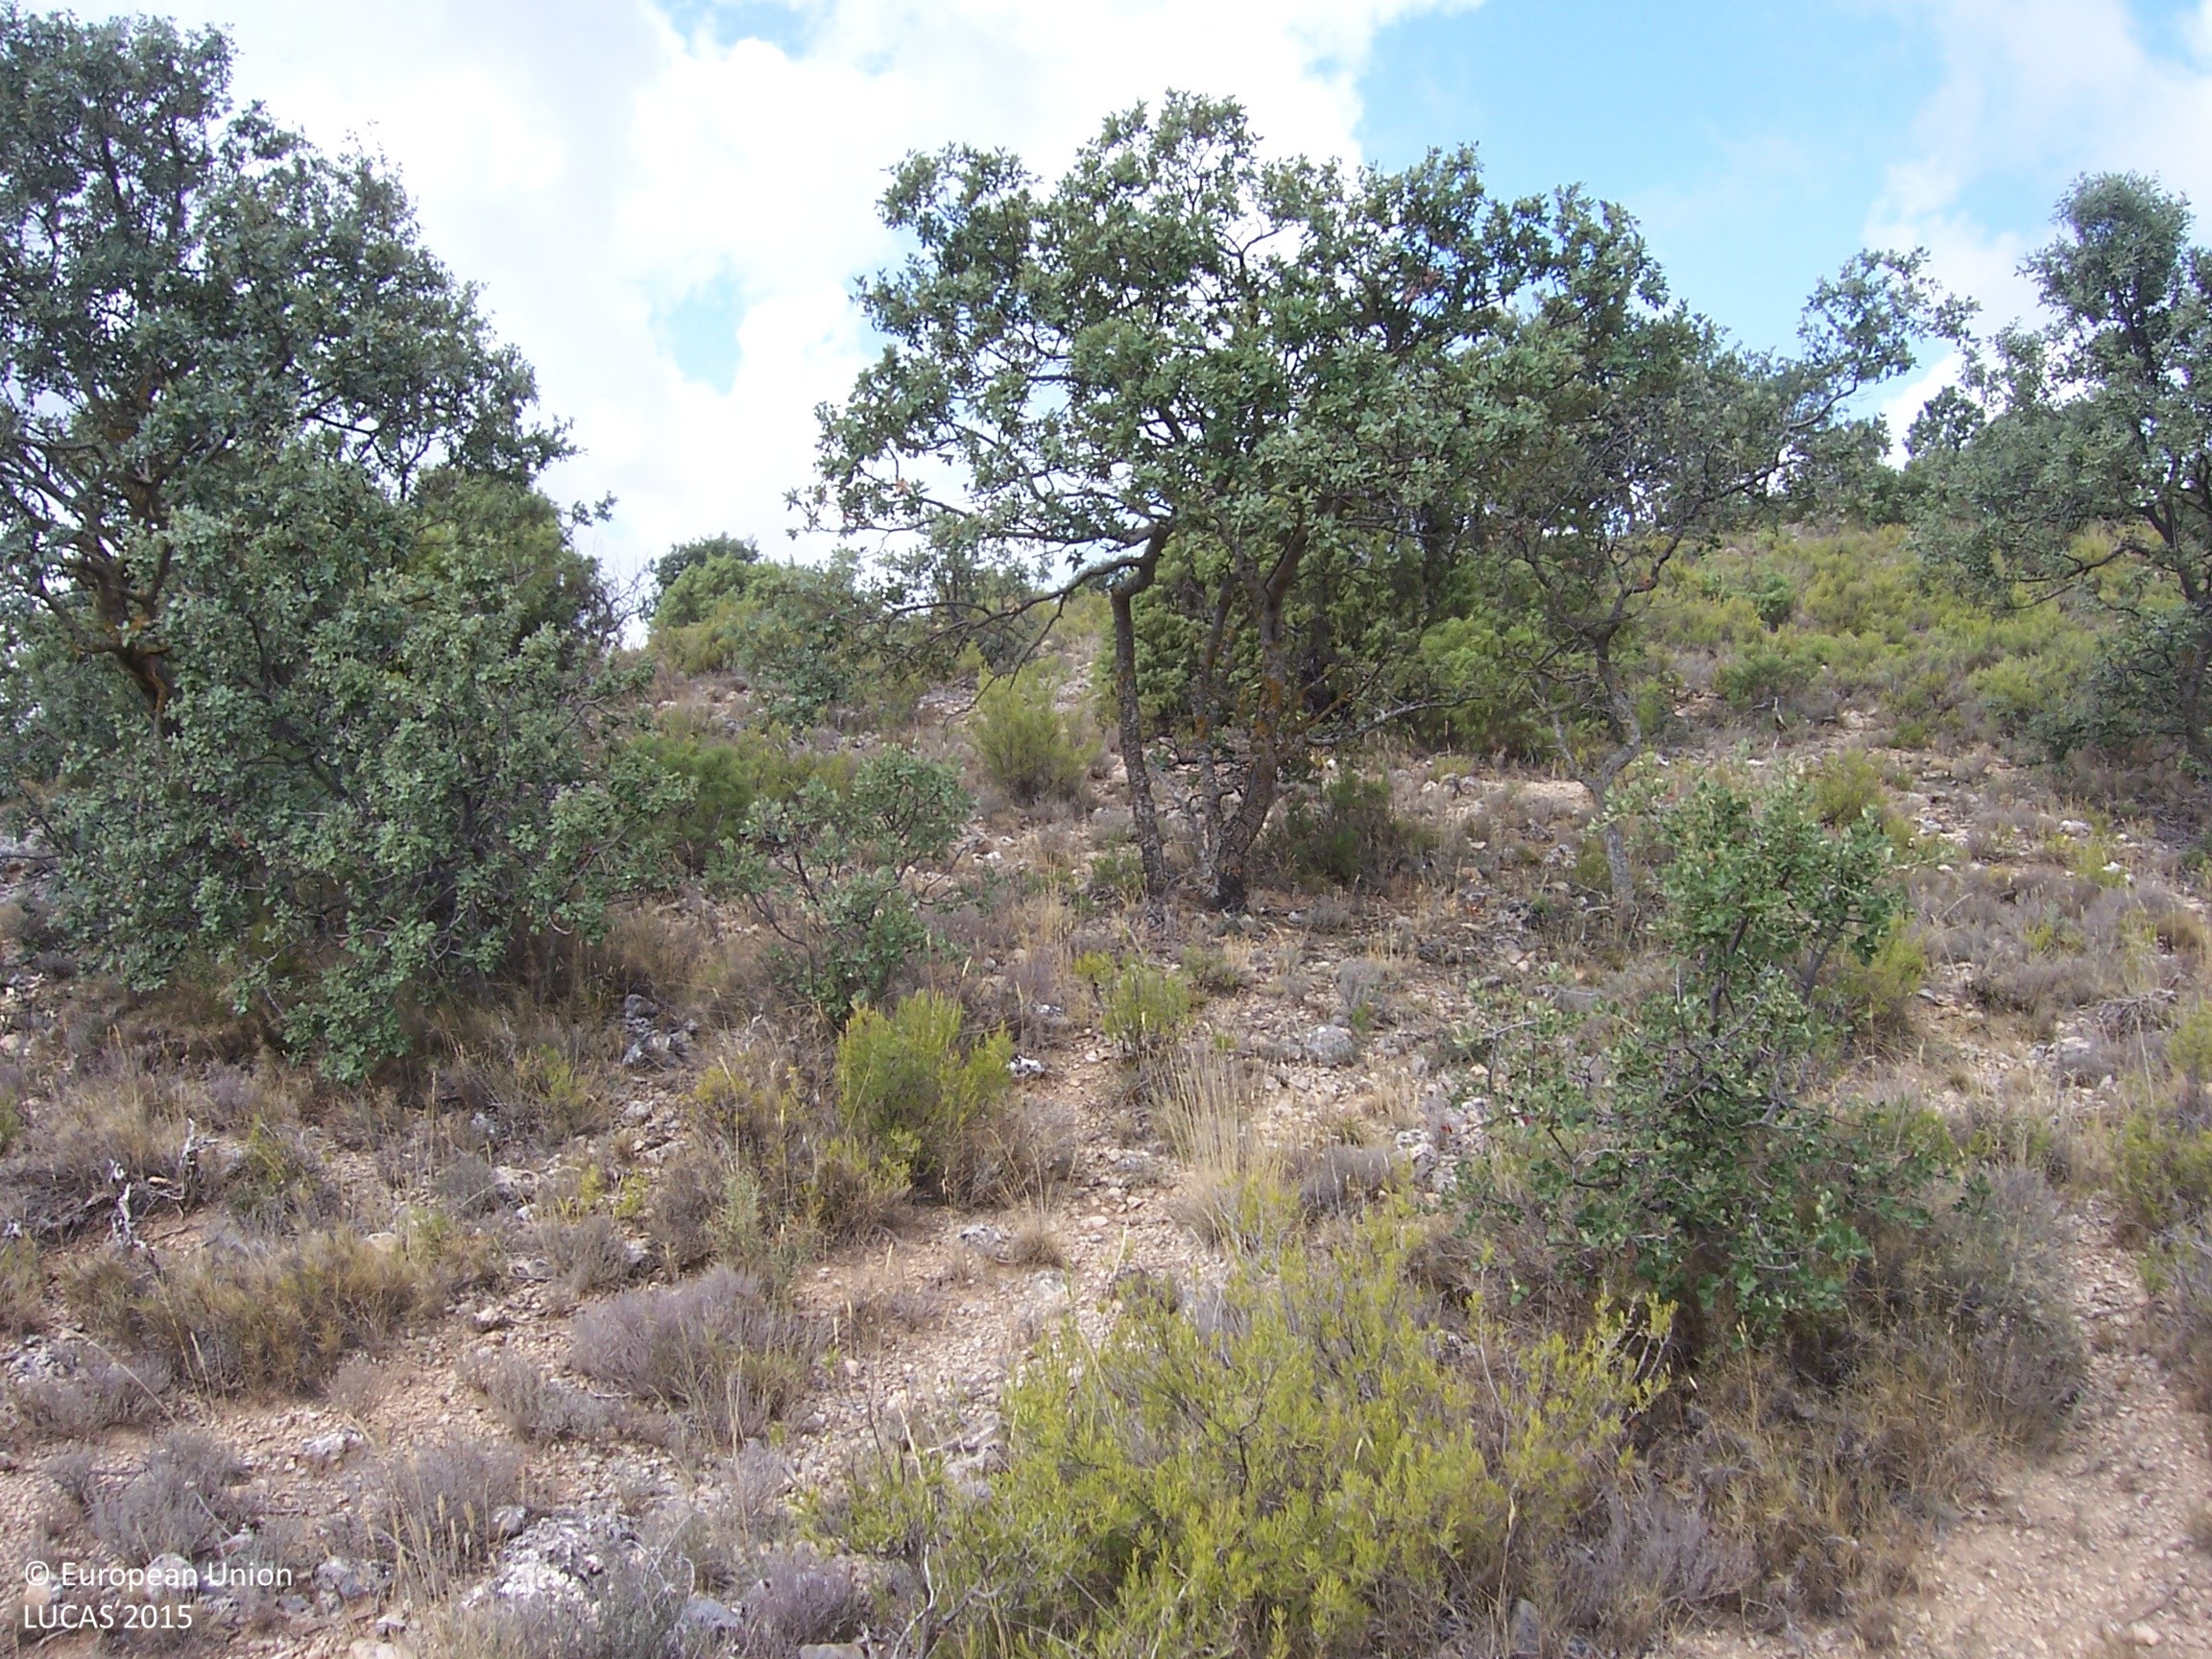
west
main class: Woodland
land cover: Broadleaved woodland
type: broadleaved evergreen forest
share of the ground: > 75 %
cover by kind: herbaceous plants 50 %, shrubs 20 %, broadleaved forest trees 15 %, unconsolidated bare surface 10 %, consolidated bare surface 5 %
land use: Semi-natural and natural areas not in use
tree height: < 5 m
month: August
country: ES
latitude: 41.8975
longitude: 0.4988
